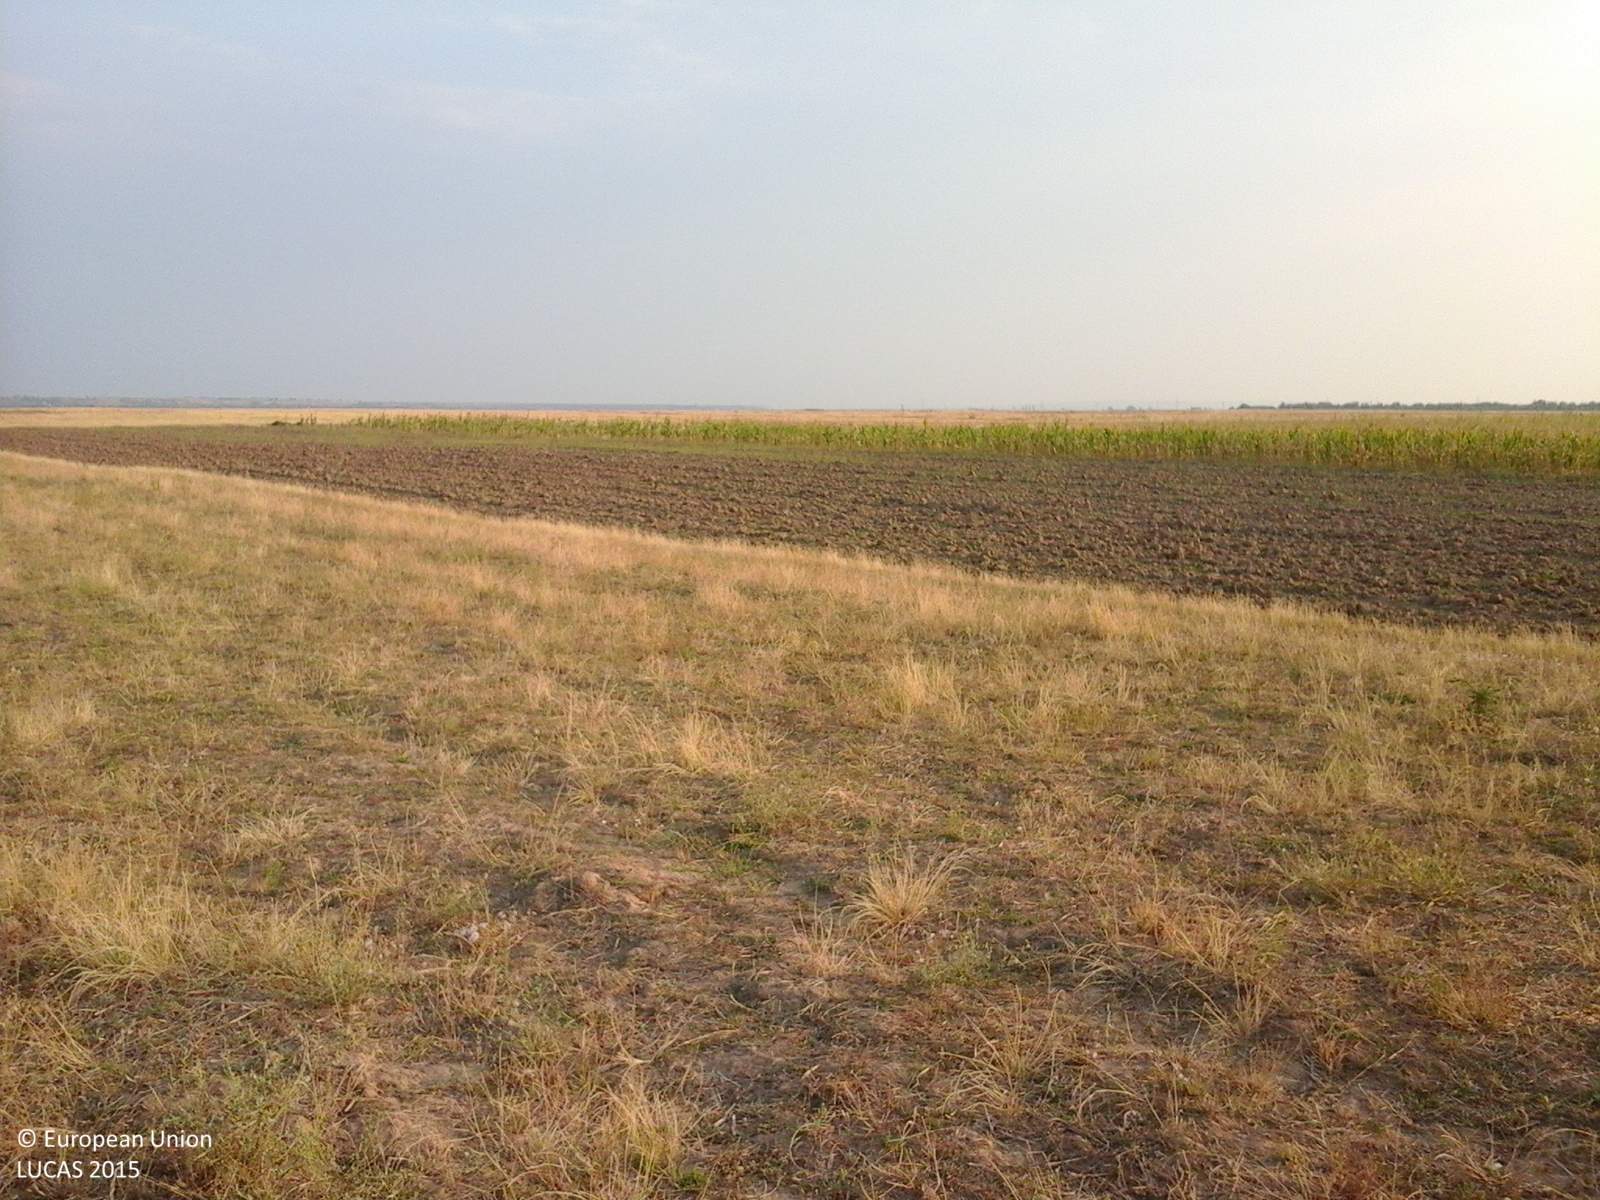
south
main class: Grassland
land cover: Spontaneously vegetated surfaces
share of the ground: > 75 %
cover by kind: herbaceous plants 100 %
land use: Fallow land
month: August
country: RO
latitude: 44.2819
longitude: 22.9620
